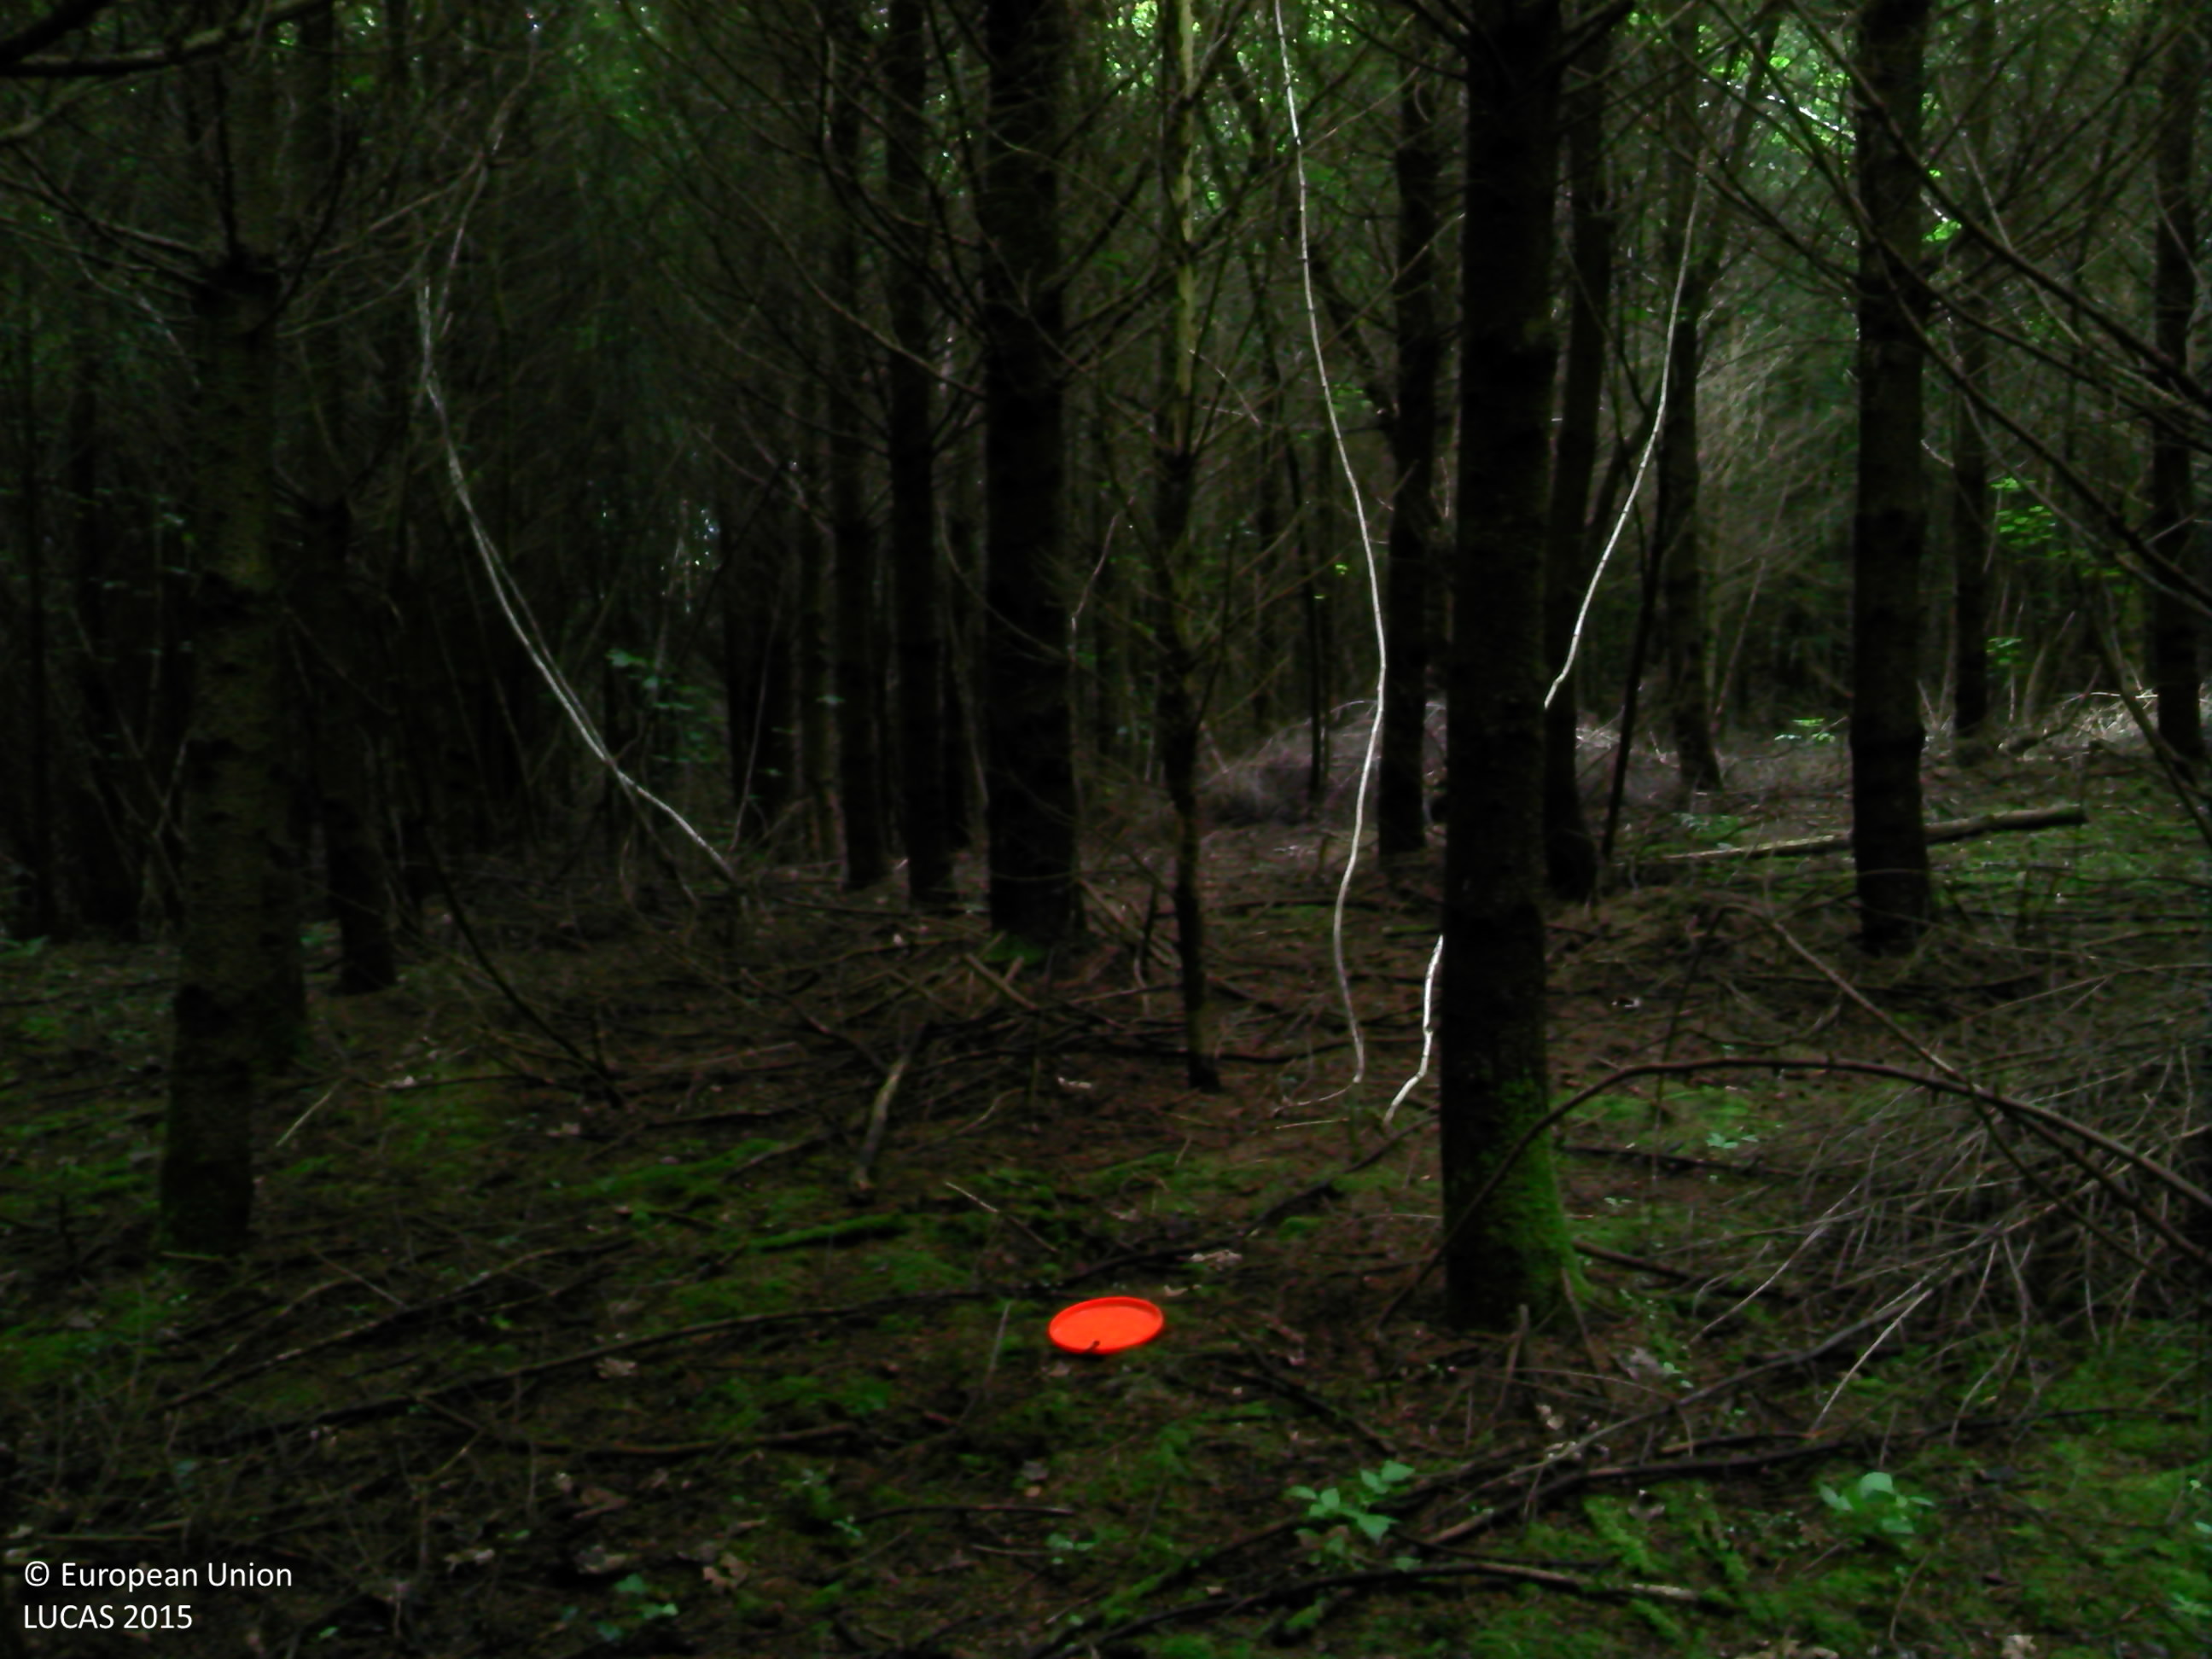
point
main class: Woodland
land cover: Spruce dominated coniferous woodland
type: exotic forest
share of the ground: > 75 %
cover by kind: coniferous forest trees 80 %, broadleaved forest trees 10 %, lichens and mosses 10 %
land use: Forestry
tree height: > 5 m
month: June
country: BE
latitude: 50.4906
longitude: 5.4735
